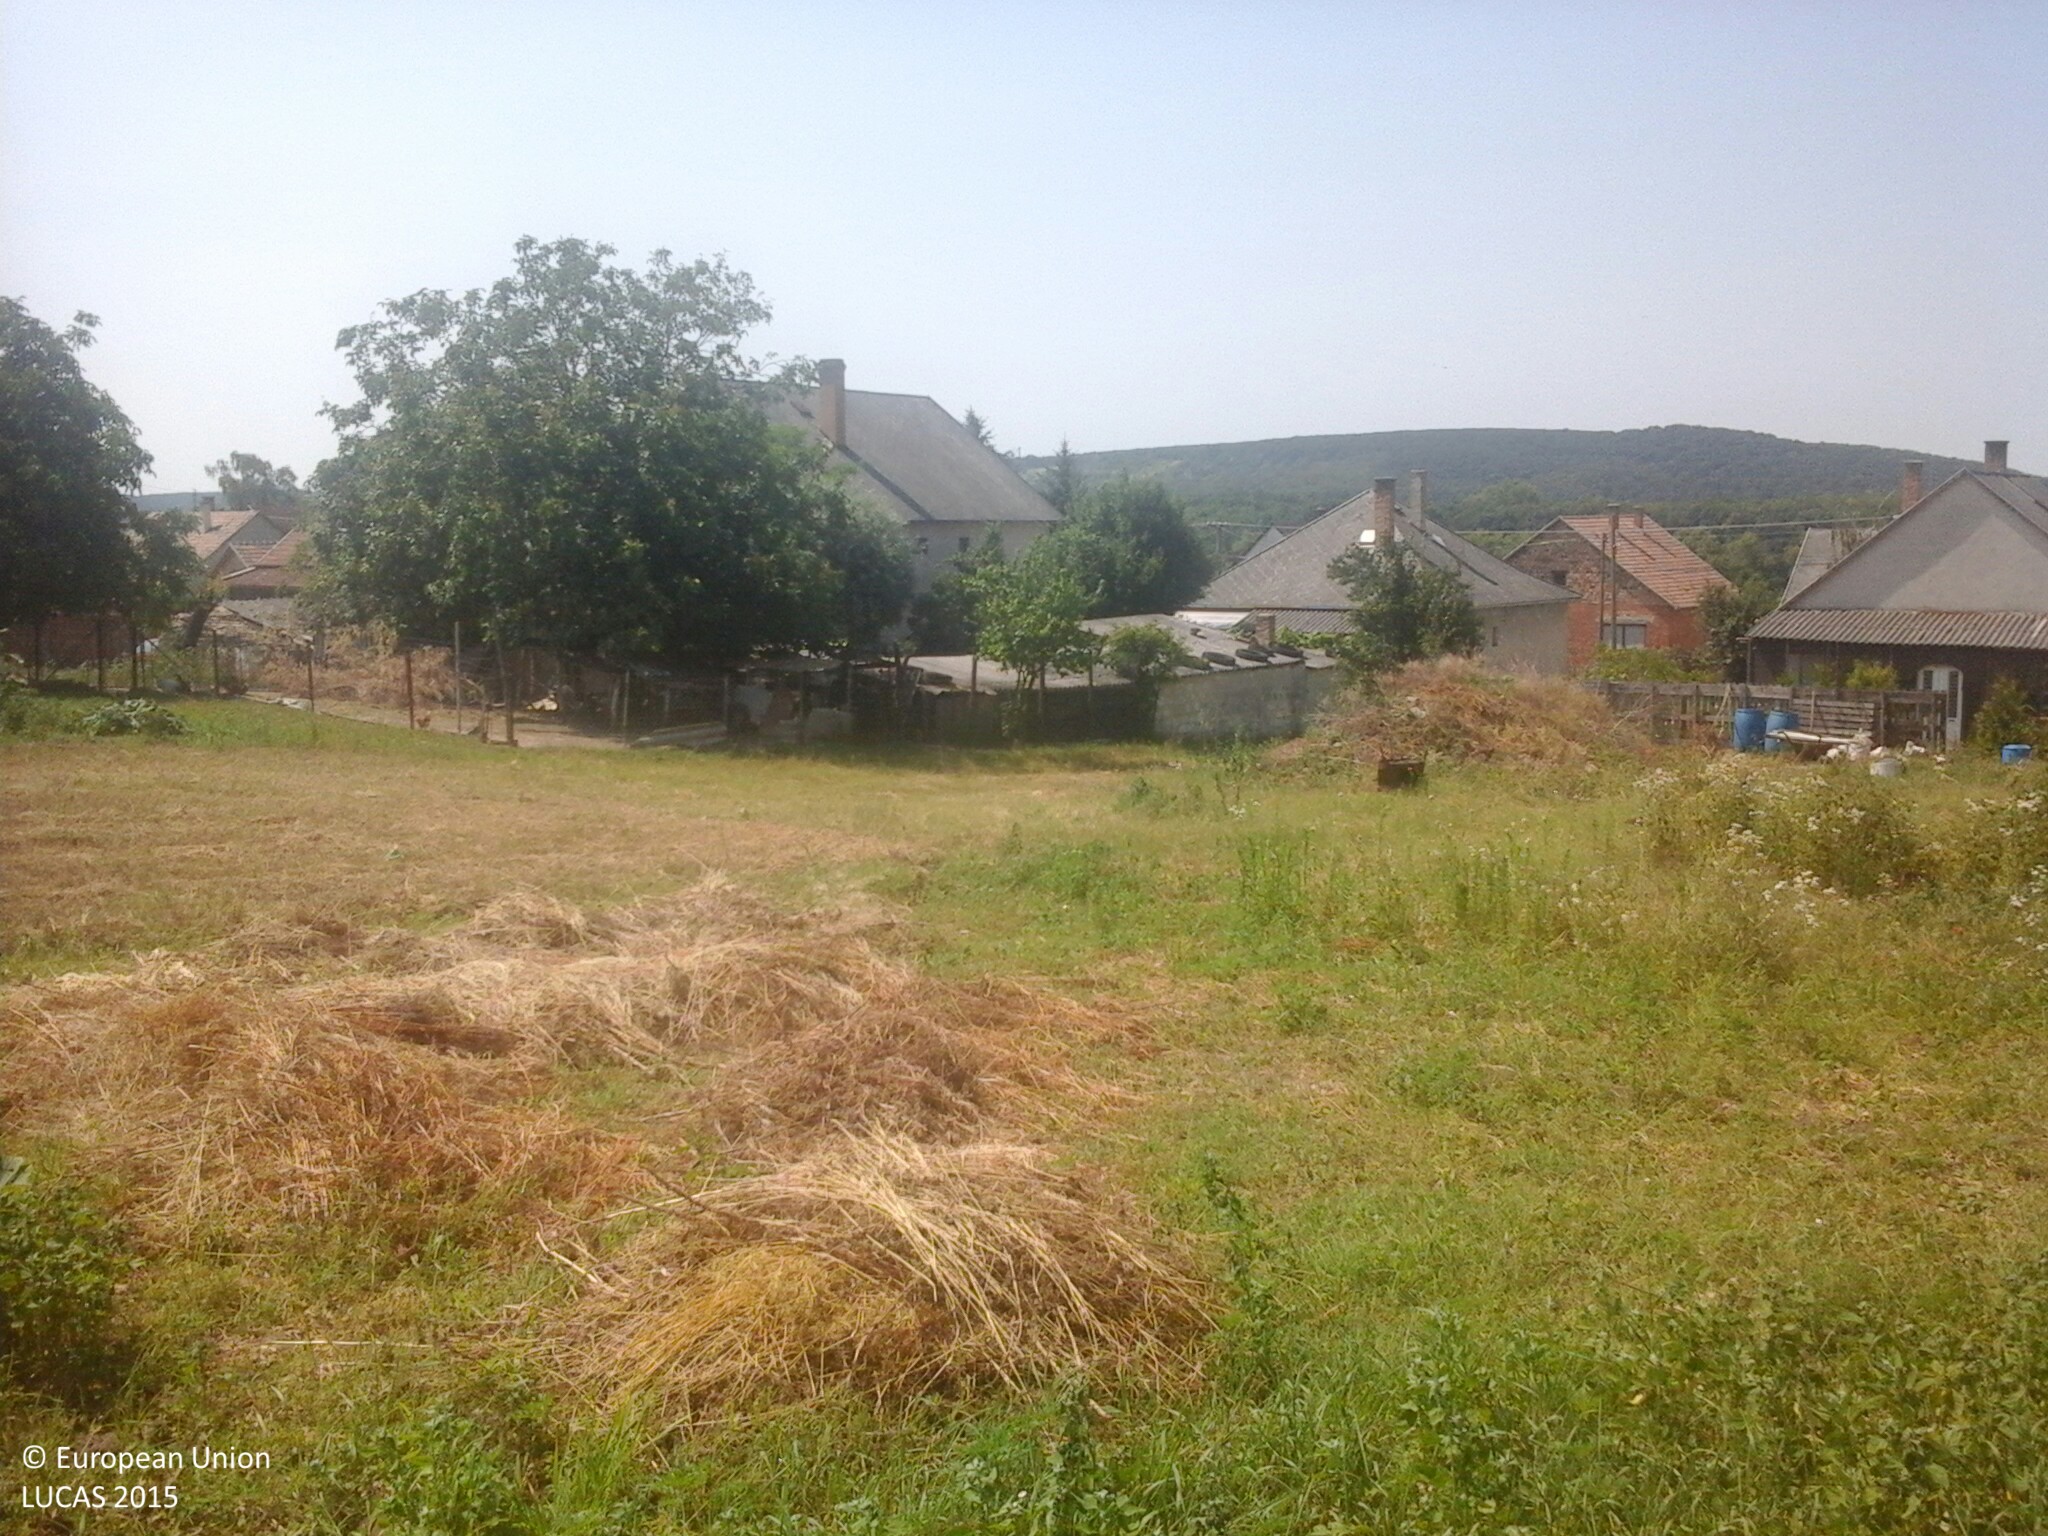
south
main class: Grassland
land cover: Spontaneously vegetated surfaces
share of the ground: > 75 %
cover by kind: herbaceous plants 100 %
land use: Agriculture (excluding fallow land and kitchen gardens)
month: July
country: HU
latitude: 47.4351
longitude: 18.5928
